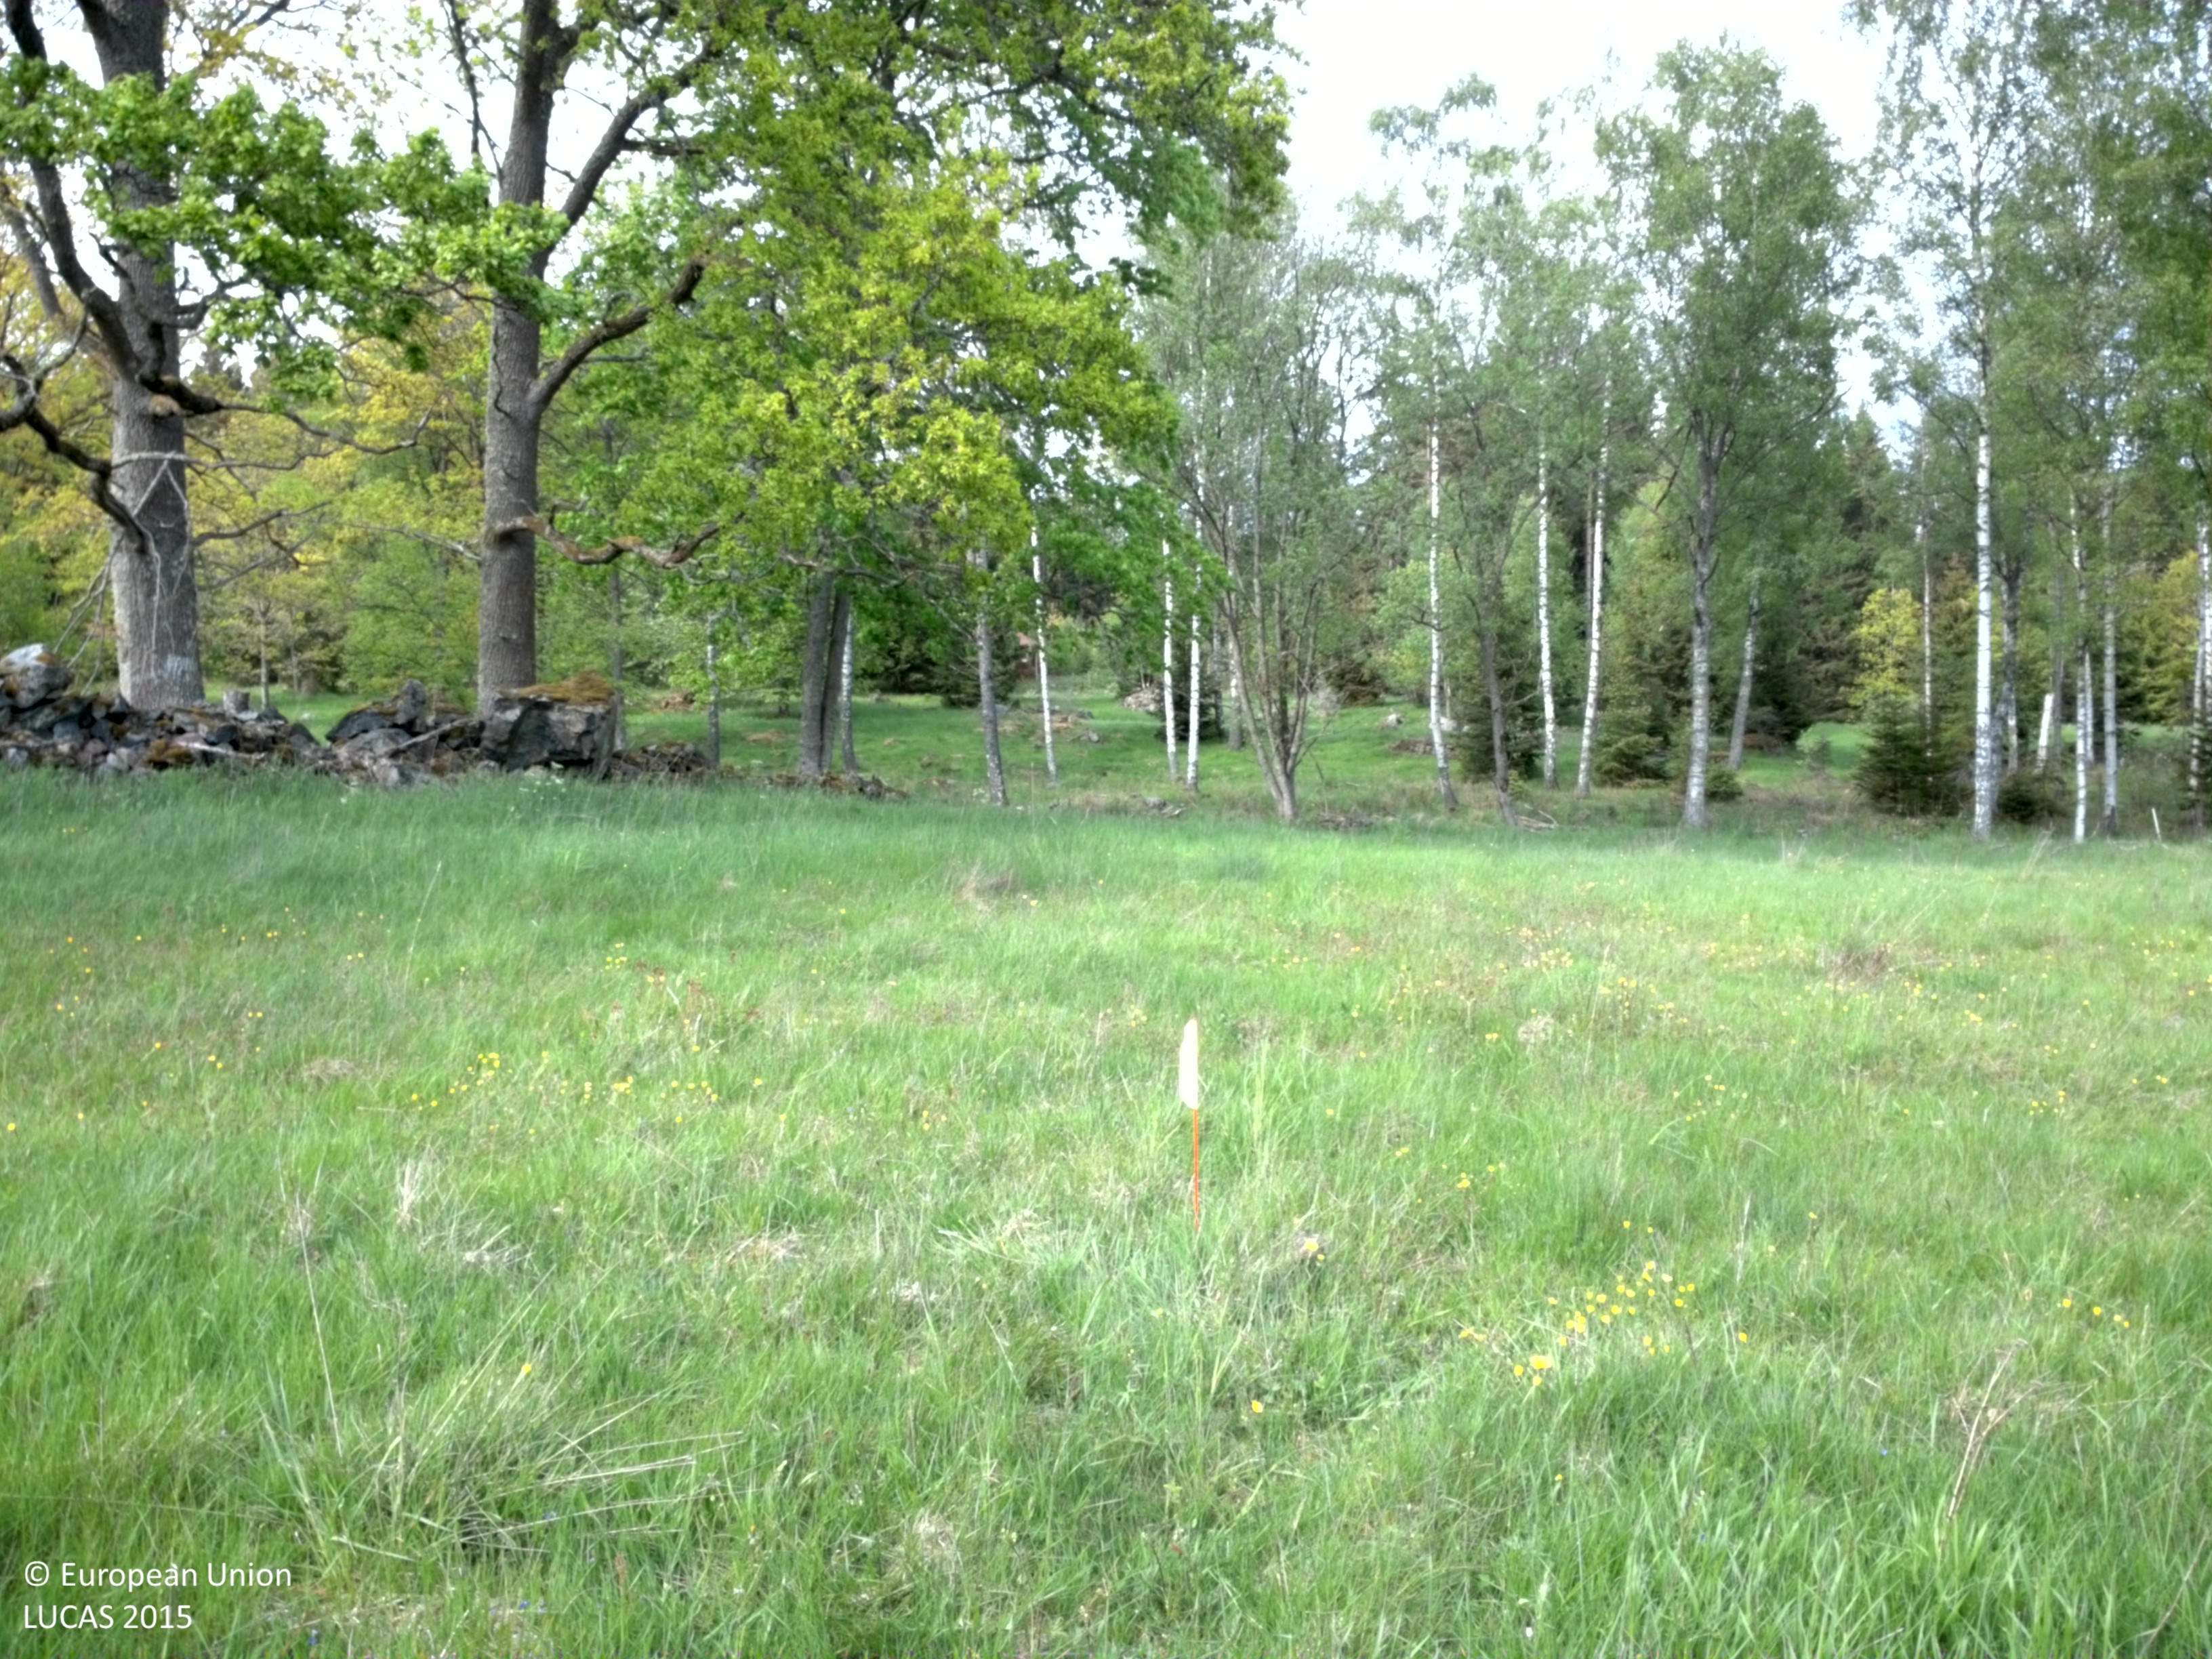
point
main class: Grassland
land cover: Grassland without tree/shrub cover
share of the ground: > 75 %
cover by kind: herbaceous plants 100 %
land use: Agriculture (excluding fallow land and kitchen gardens)
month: May
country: SE
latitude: 57.4269
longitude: 15.3760
